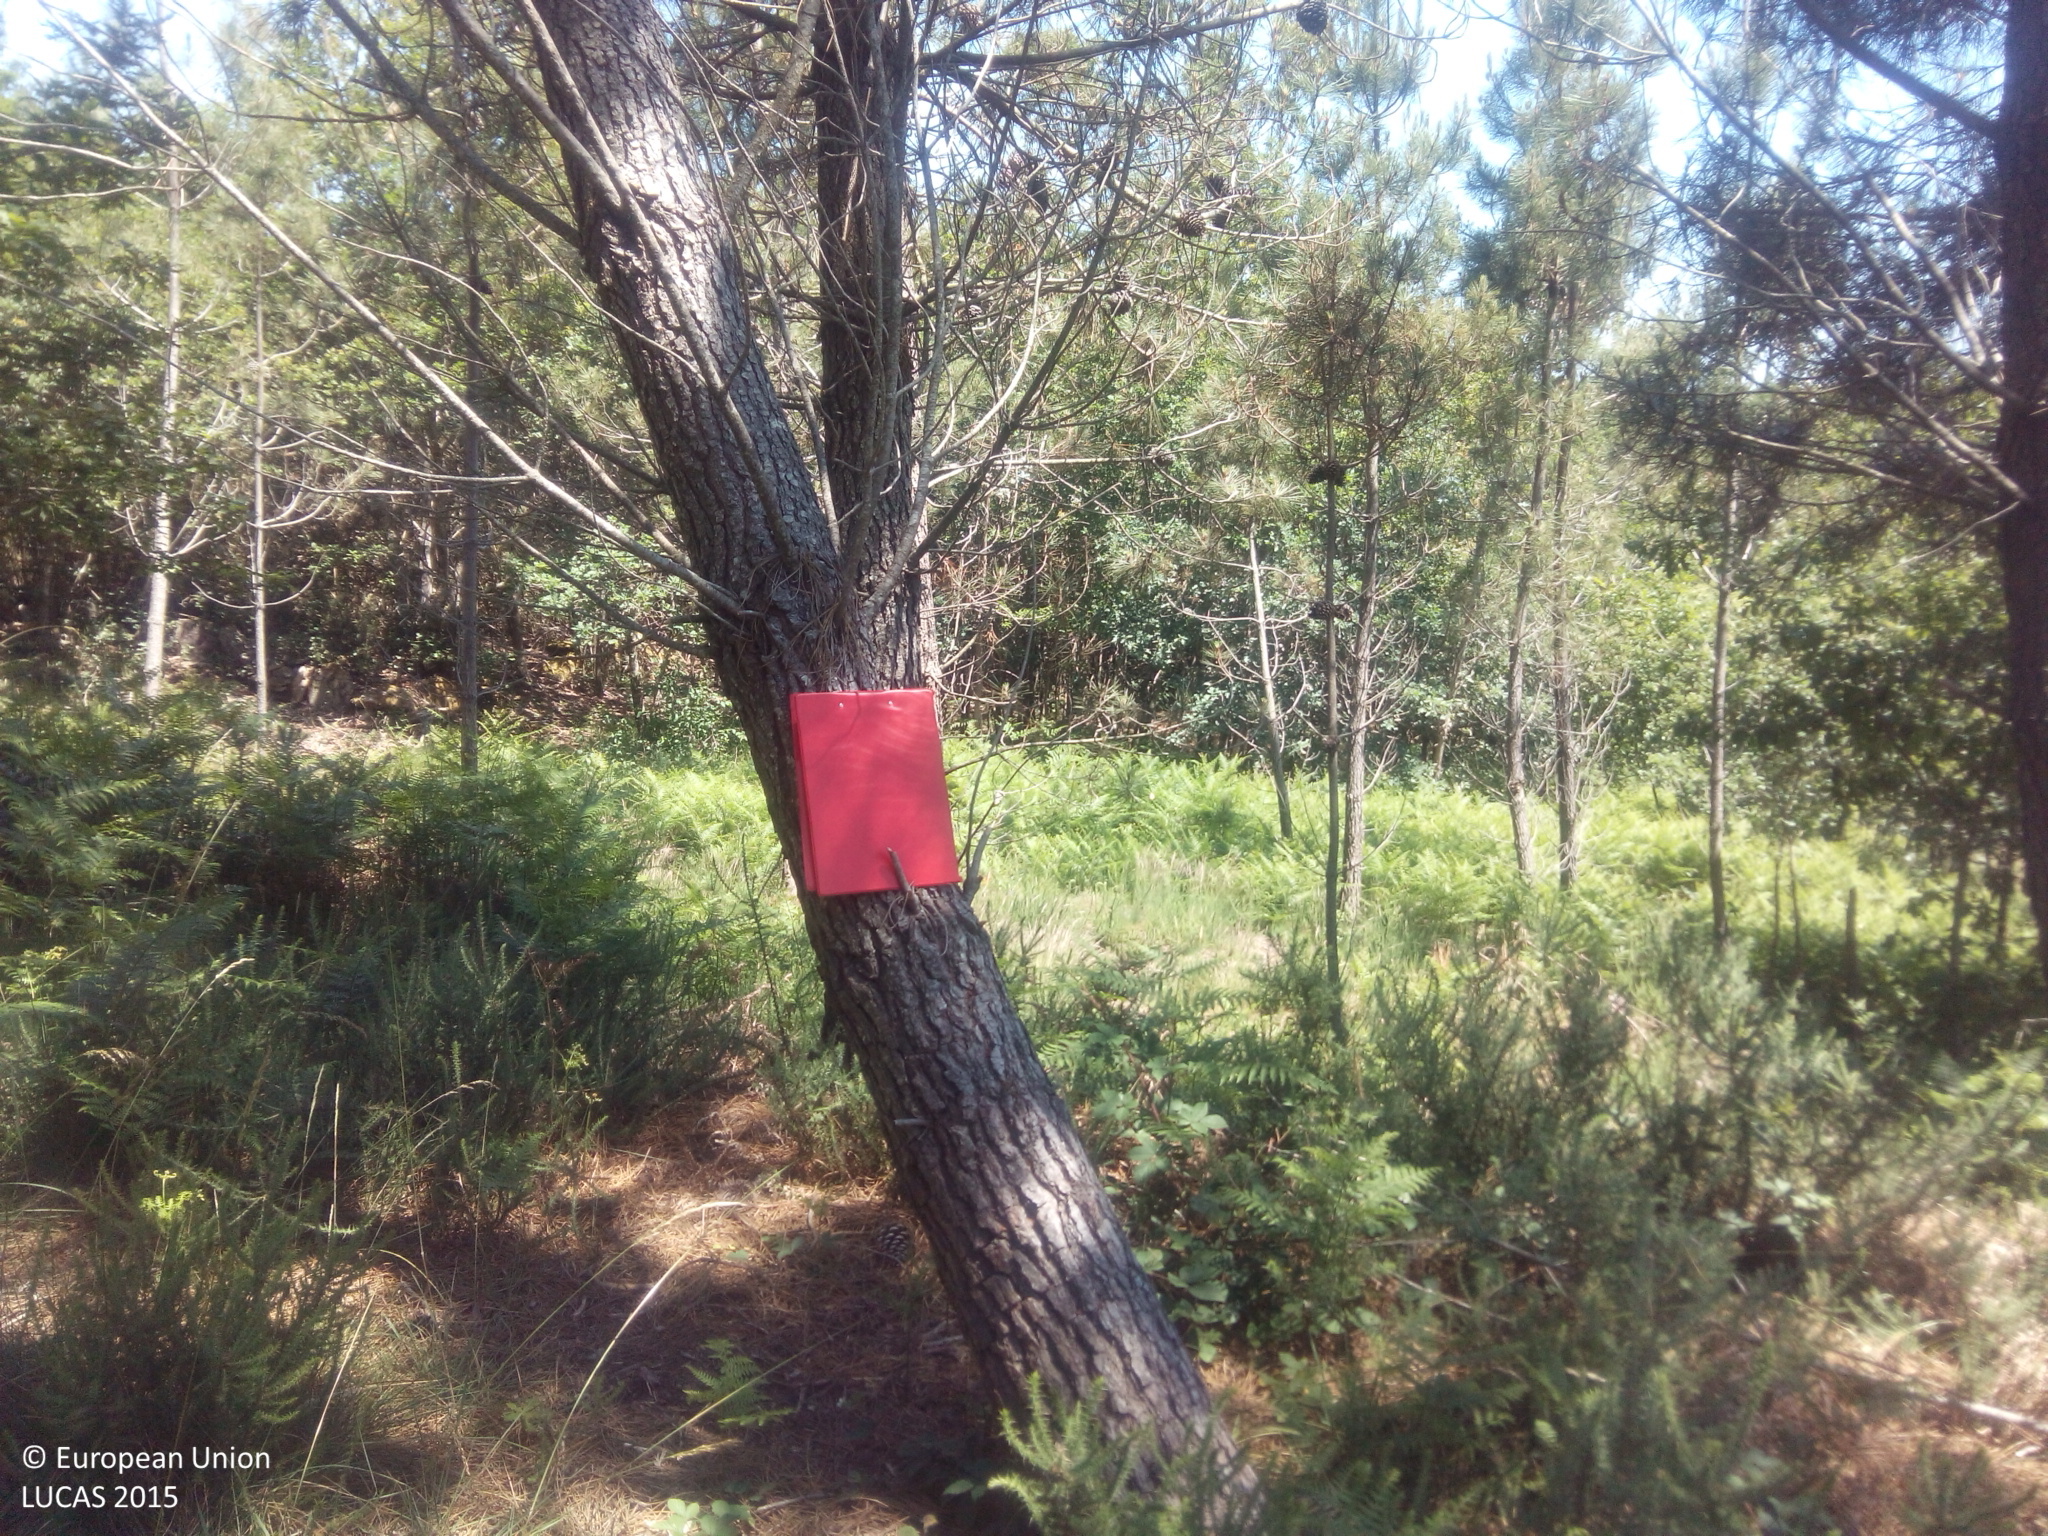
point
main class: Woodland
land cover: Pine dominated coniferous woodland
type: hemiboreal forest and nemoral coniferous forest and mixed broadleaved-coniferous forest
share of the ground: > 75 %
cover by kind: coniferous forest trees 60 %, shrubs 25 %, herbaceous plants 15 %
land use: Forestry
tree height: > 5 m
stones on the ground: < 10 %
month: June
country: ES
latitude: 42.4663
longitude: -8.2980
